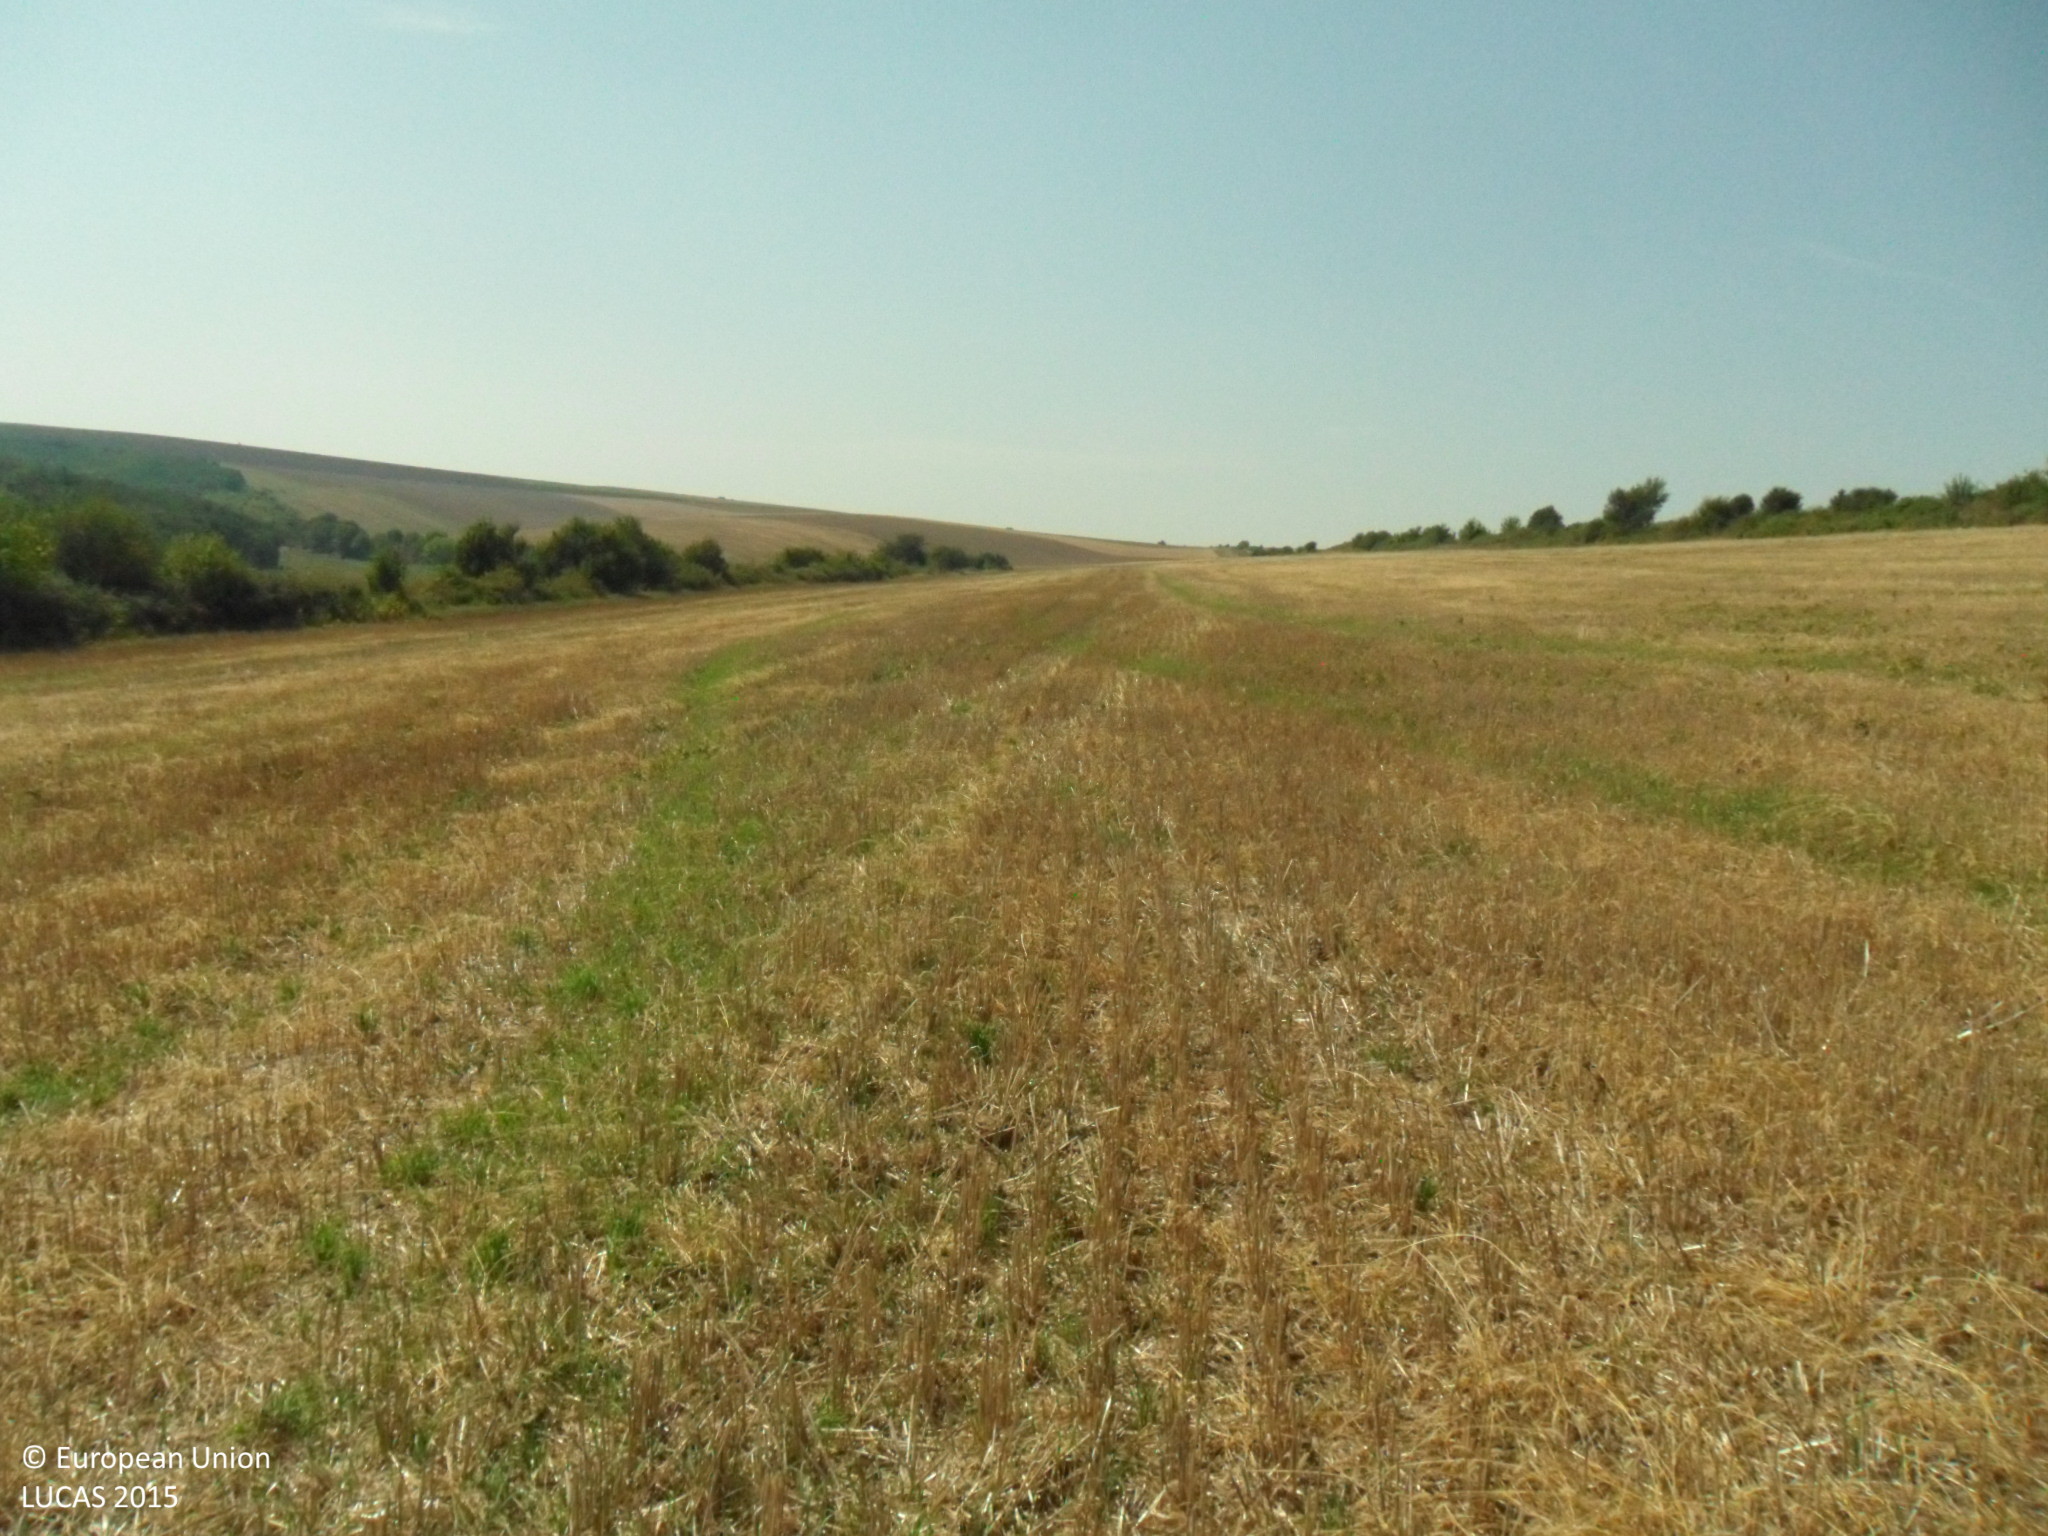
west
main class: Cropland
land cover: Common wheat
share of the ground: 25 - 50 %
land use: Agriculture (excluding fallow land and kitchen gardens)
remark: Harvested field
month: September
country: BG
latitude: 43.5819
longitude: 26.0836
